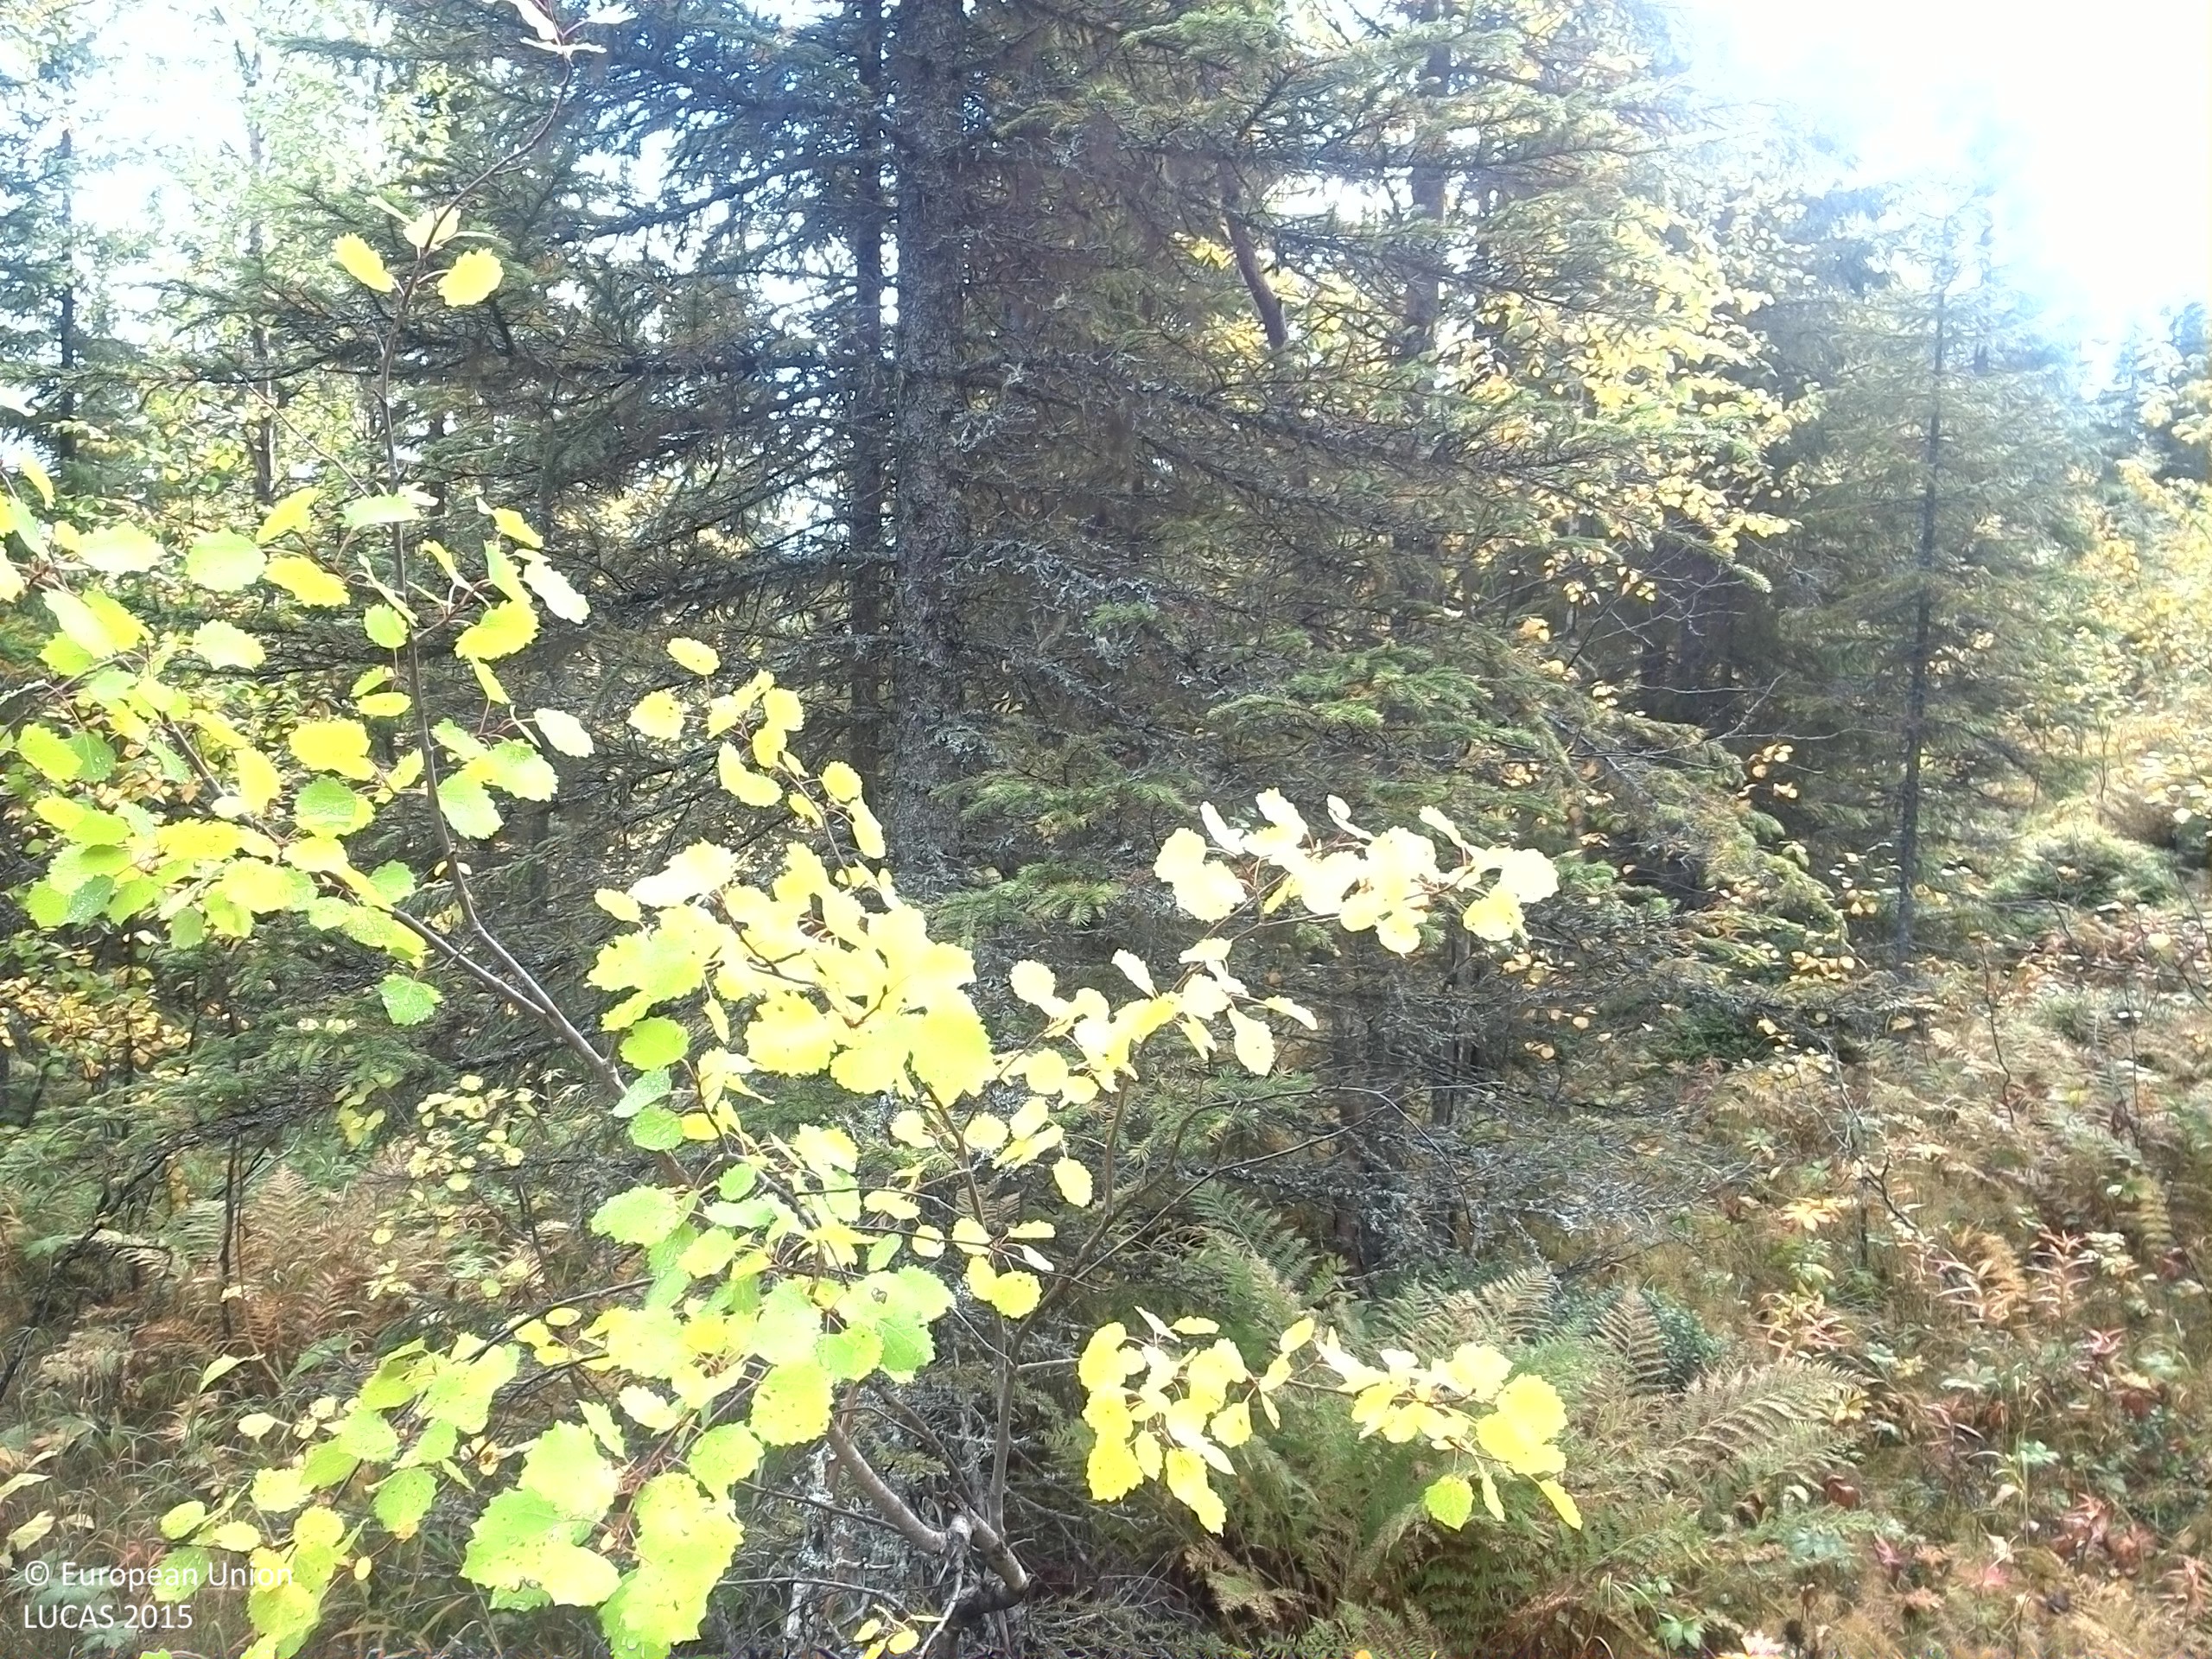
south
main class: Woodland
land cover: Spruce dominated mixed woodland
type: boreal forest
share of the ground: > 75 %
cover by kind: coniferous forest trees 55 %, broadleaved forest trees 20 %, herbaceous plants 15 %, shrubs 5 %, lichens and mosses 5 %
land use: Forestry
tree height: > 5 m
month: September
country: SE
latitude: 63.5817
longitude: 15.9169
